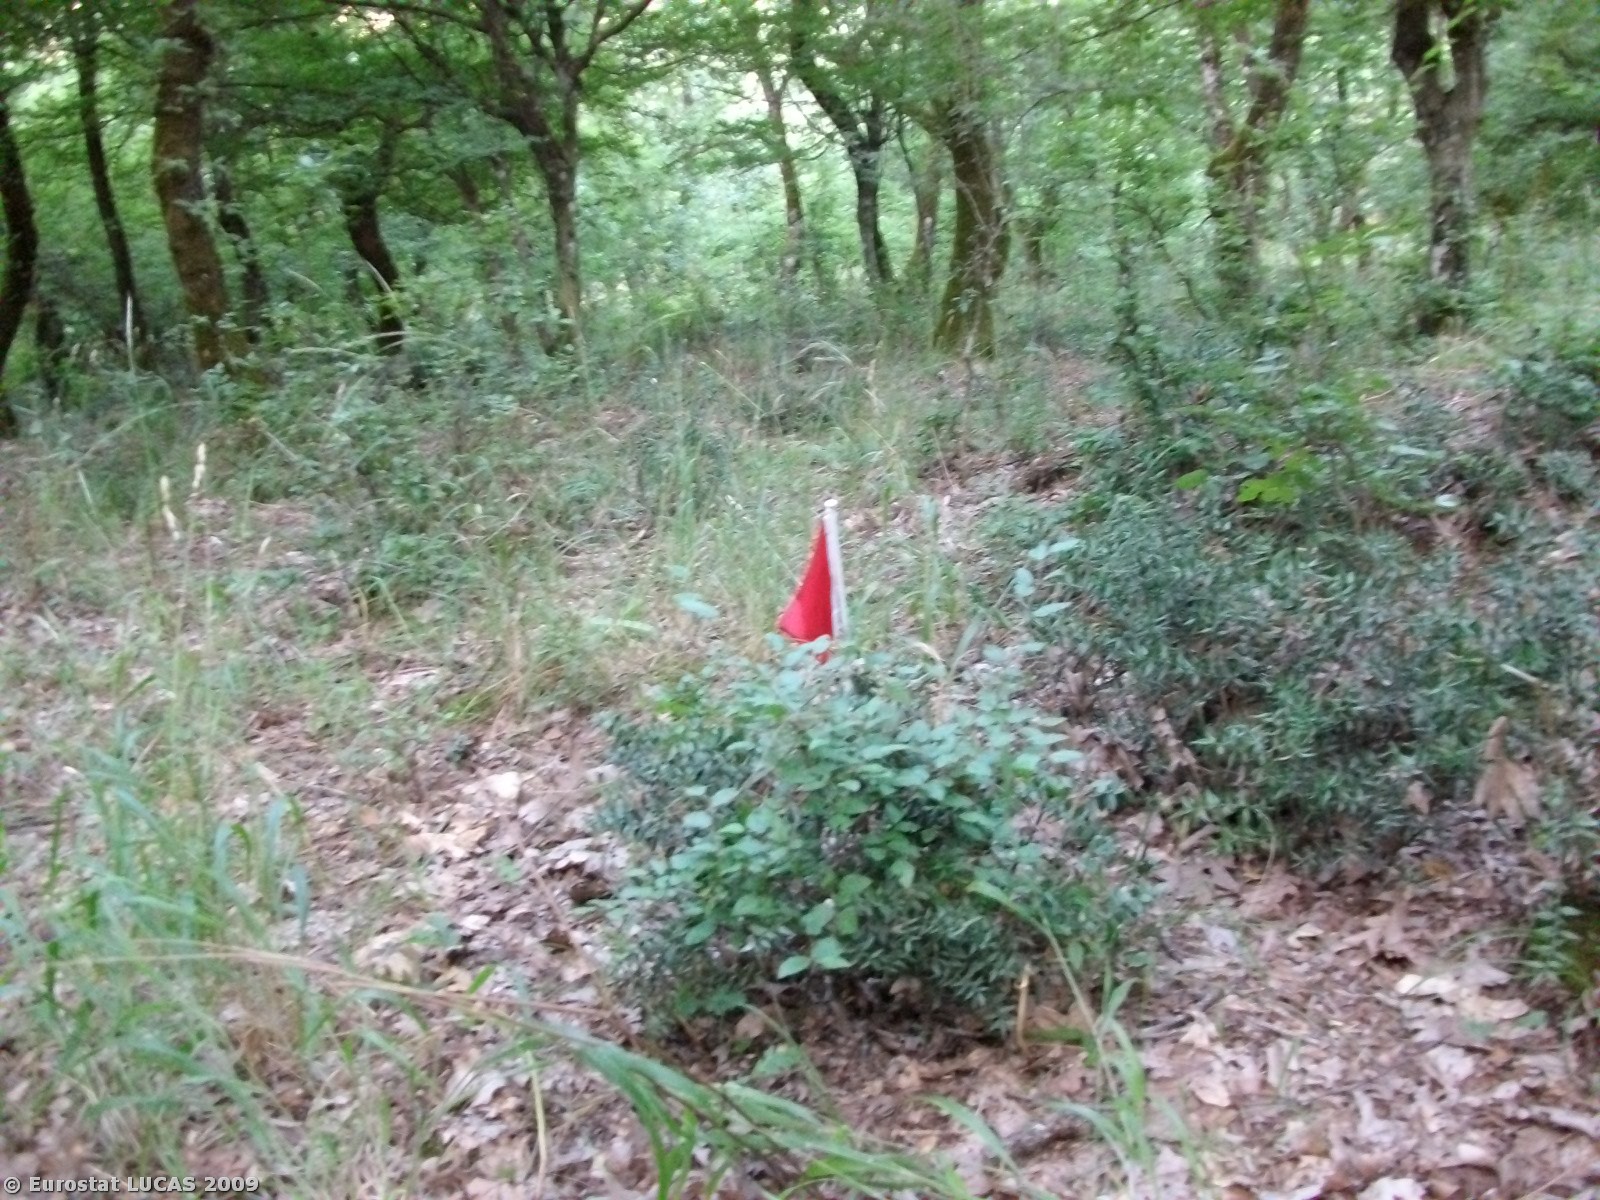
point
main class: Woodland
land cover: Broadleaved woodland
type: broadleaved evergreen forest
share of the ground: > 75 %
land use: Forestry
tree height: > 5 m
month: July
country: GR
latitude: 39.5395
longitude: 21.6059
